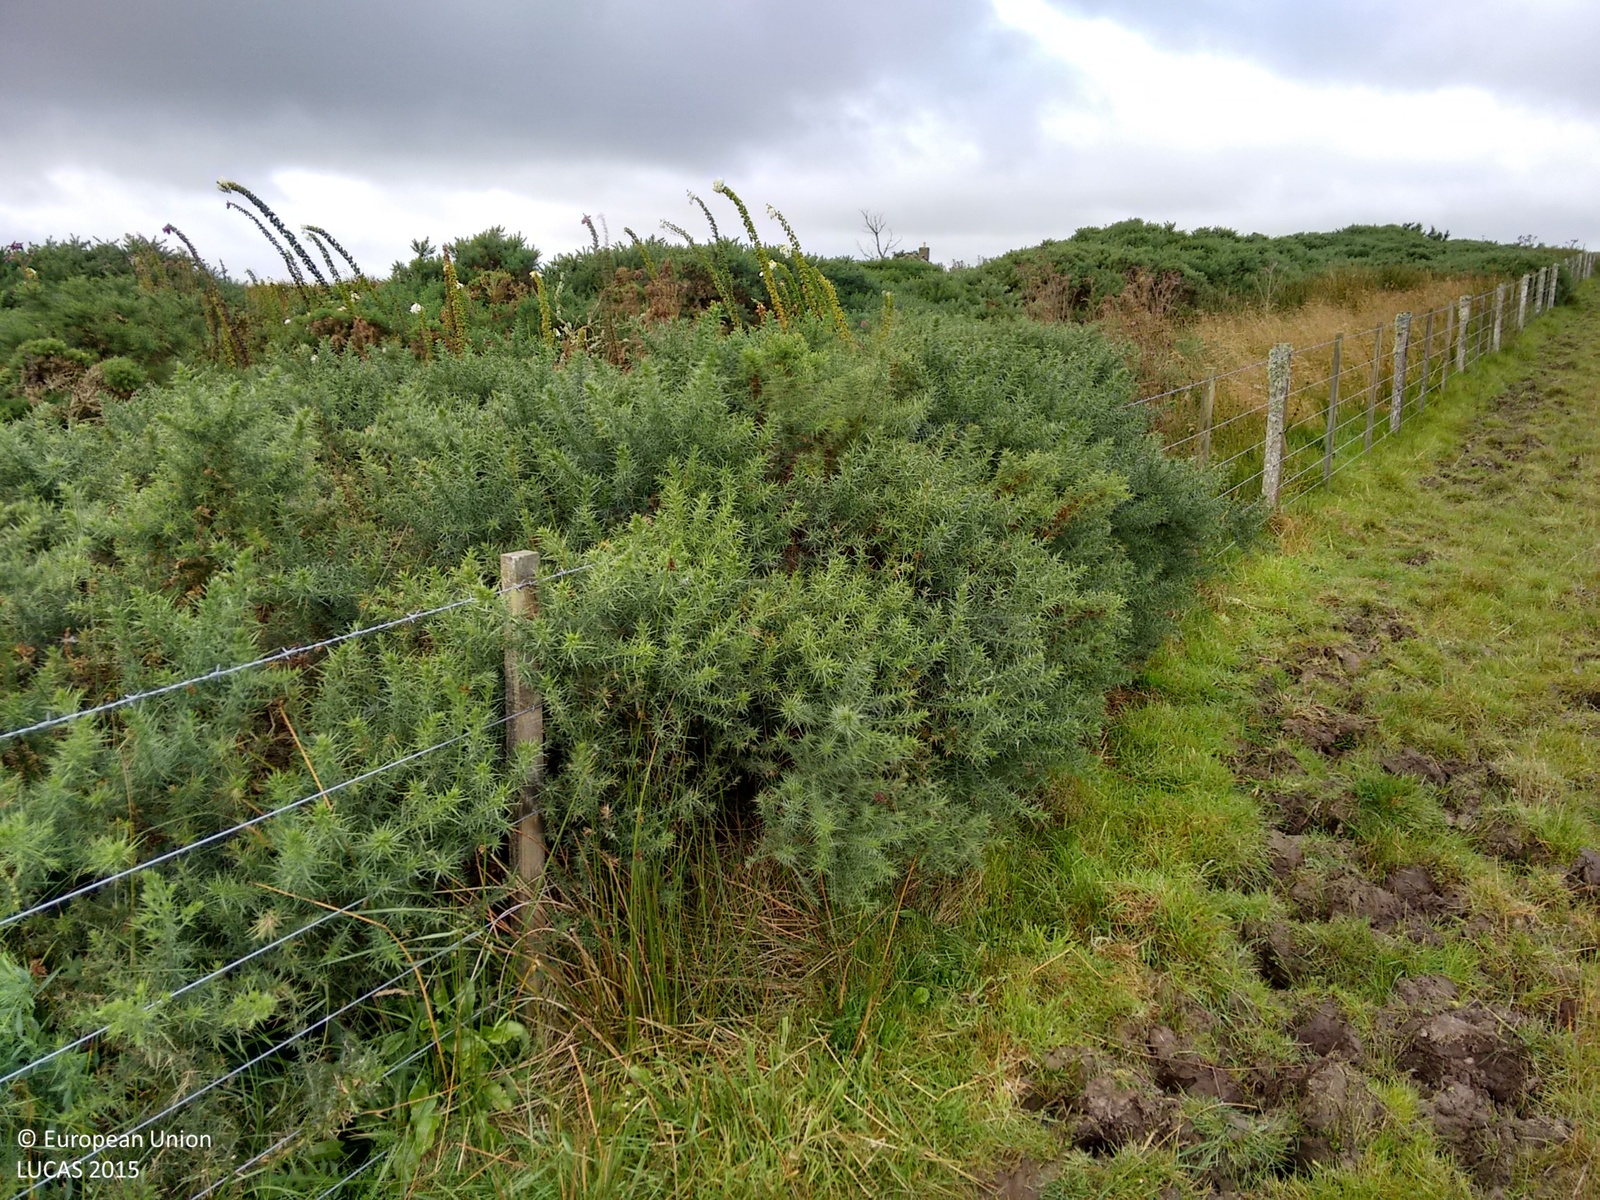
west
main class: Grassland
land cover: Grassland without tree/shrub cover
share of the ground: > 75 %
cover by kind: herbaceous plants 100 %
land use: Agriculture (excluding fallow land and kitchen gardens)
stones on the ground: < 10 %
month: August
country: GB
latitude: 58.4912
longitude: -3.2522
